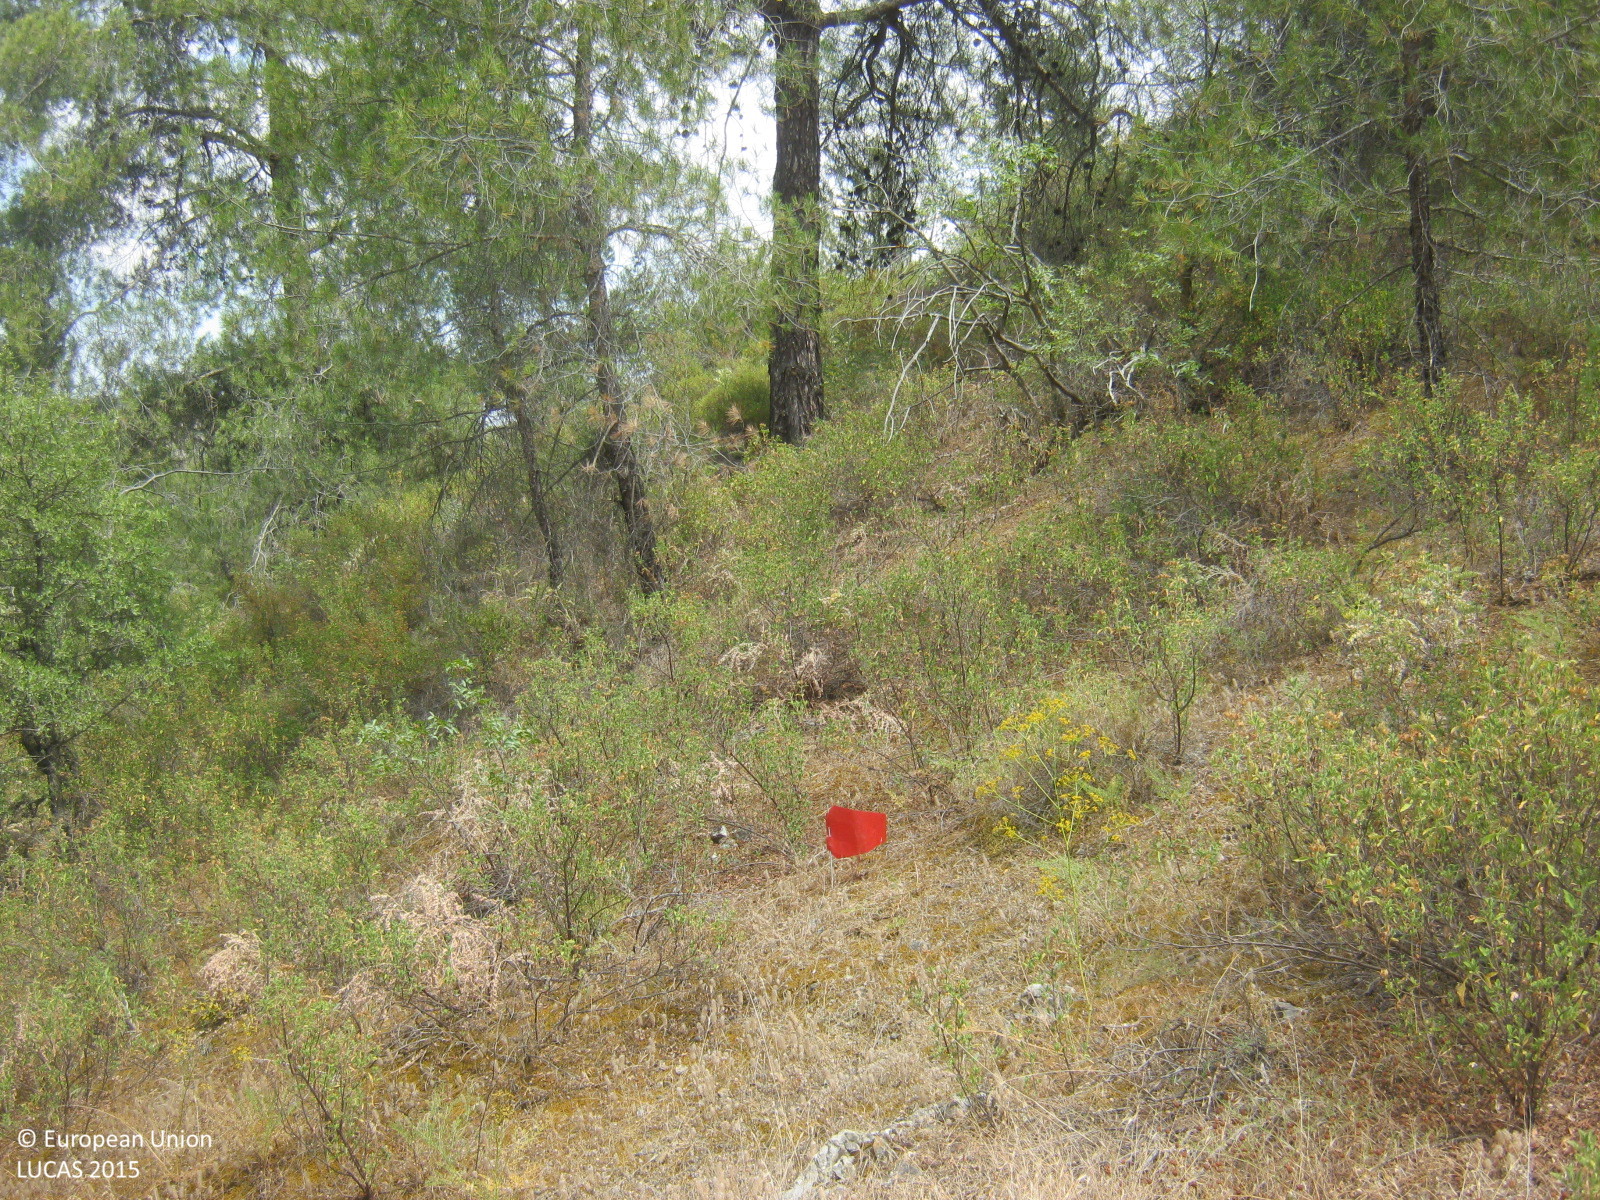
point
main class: Woodland
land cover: Pine dominated coniferous woodland
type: coniferous forest of the mediterranean region
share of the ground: 50 - 75 %
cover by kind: coniferous forest trees 60 %, shrubs 20 %, herbaceous plants 10 %, unconsolidated bare surface 10 %
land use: Forestry
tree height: > 5 m
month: June
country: CY
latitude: 34.9752
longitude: 33.1711
